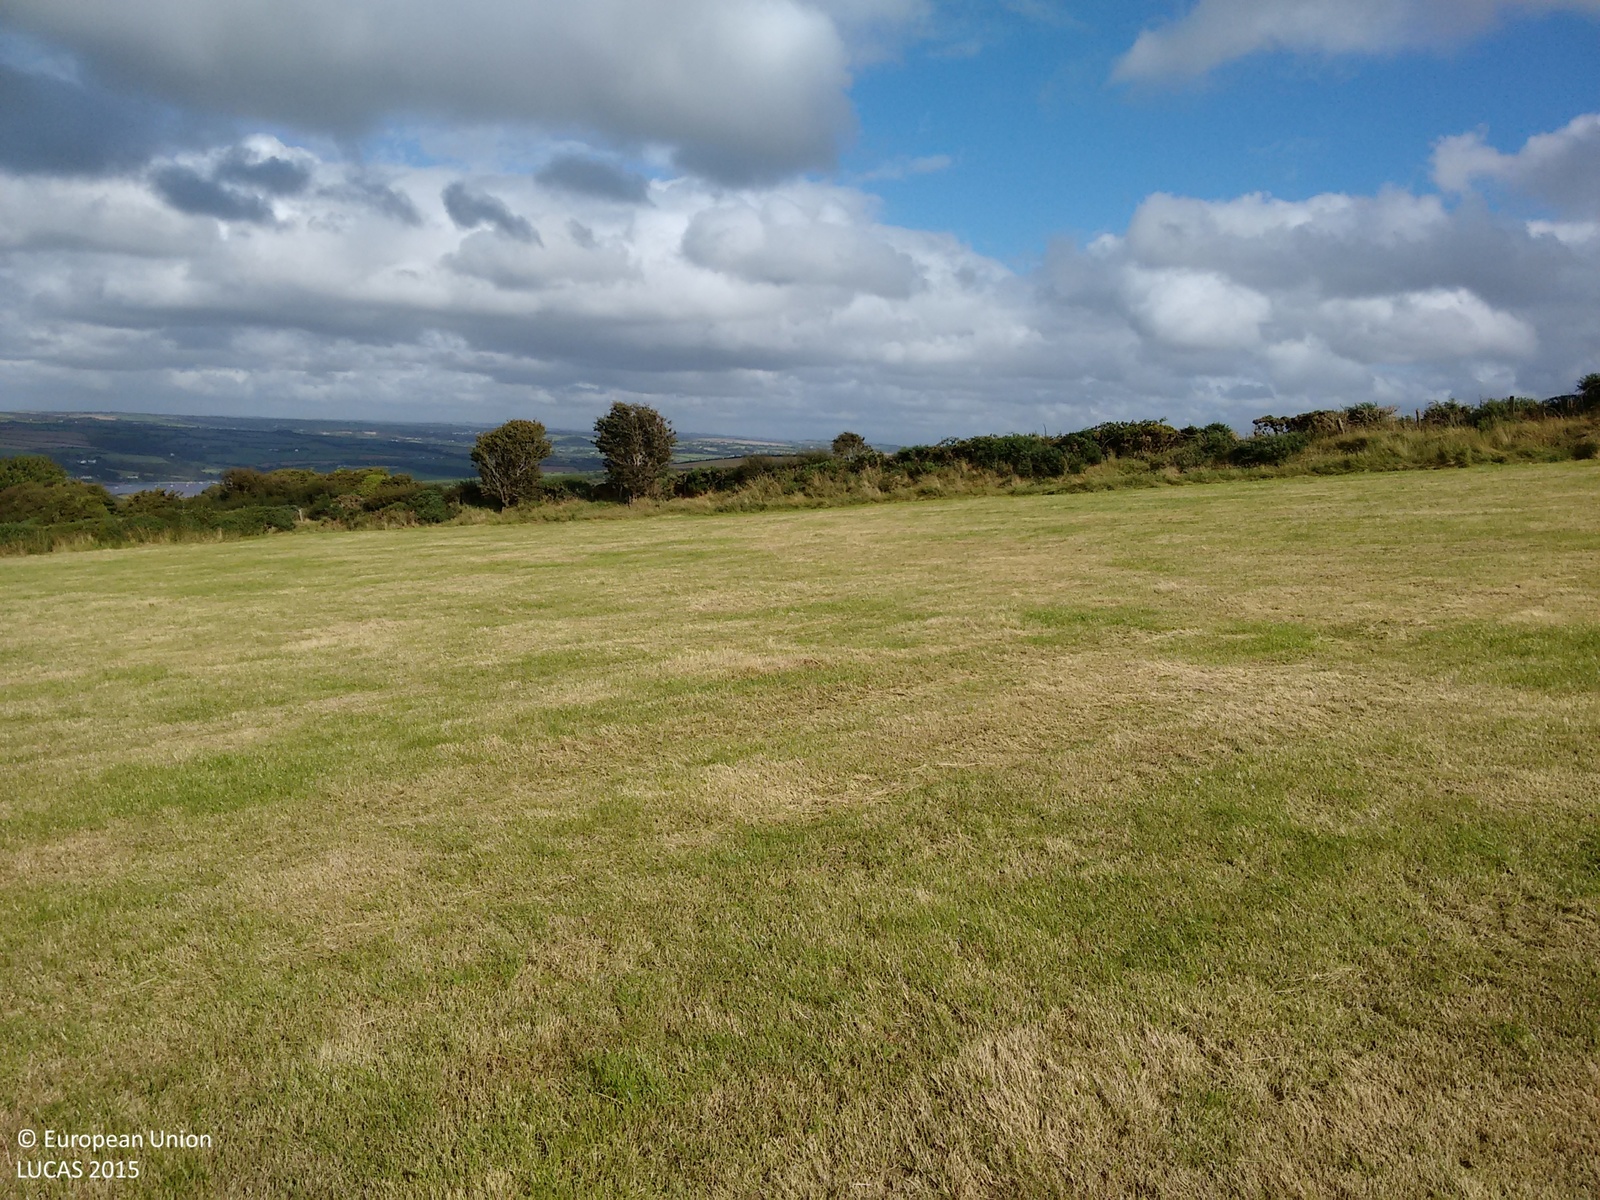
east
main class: Grassland
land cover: Grassland without tree/shrub cover
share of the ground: > 75 %
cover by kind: herbaceous plants 75 %, consolidated bare surface 25 %
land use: Agriculture (excluding fallow land and kitchen gardens)
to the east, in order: Grassland without tree/shrub cover; Fences; Managed hedges; Fences; Other fibre and oleaginous crops; Fences; Managed hedges; Fences; Temporary grasslands
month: August
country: GB
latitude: 52.0928
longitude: -4.7212
